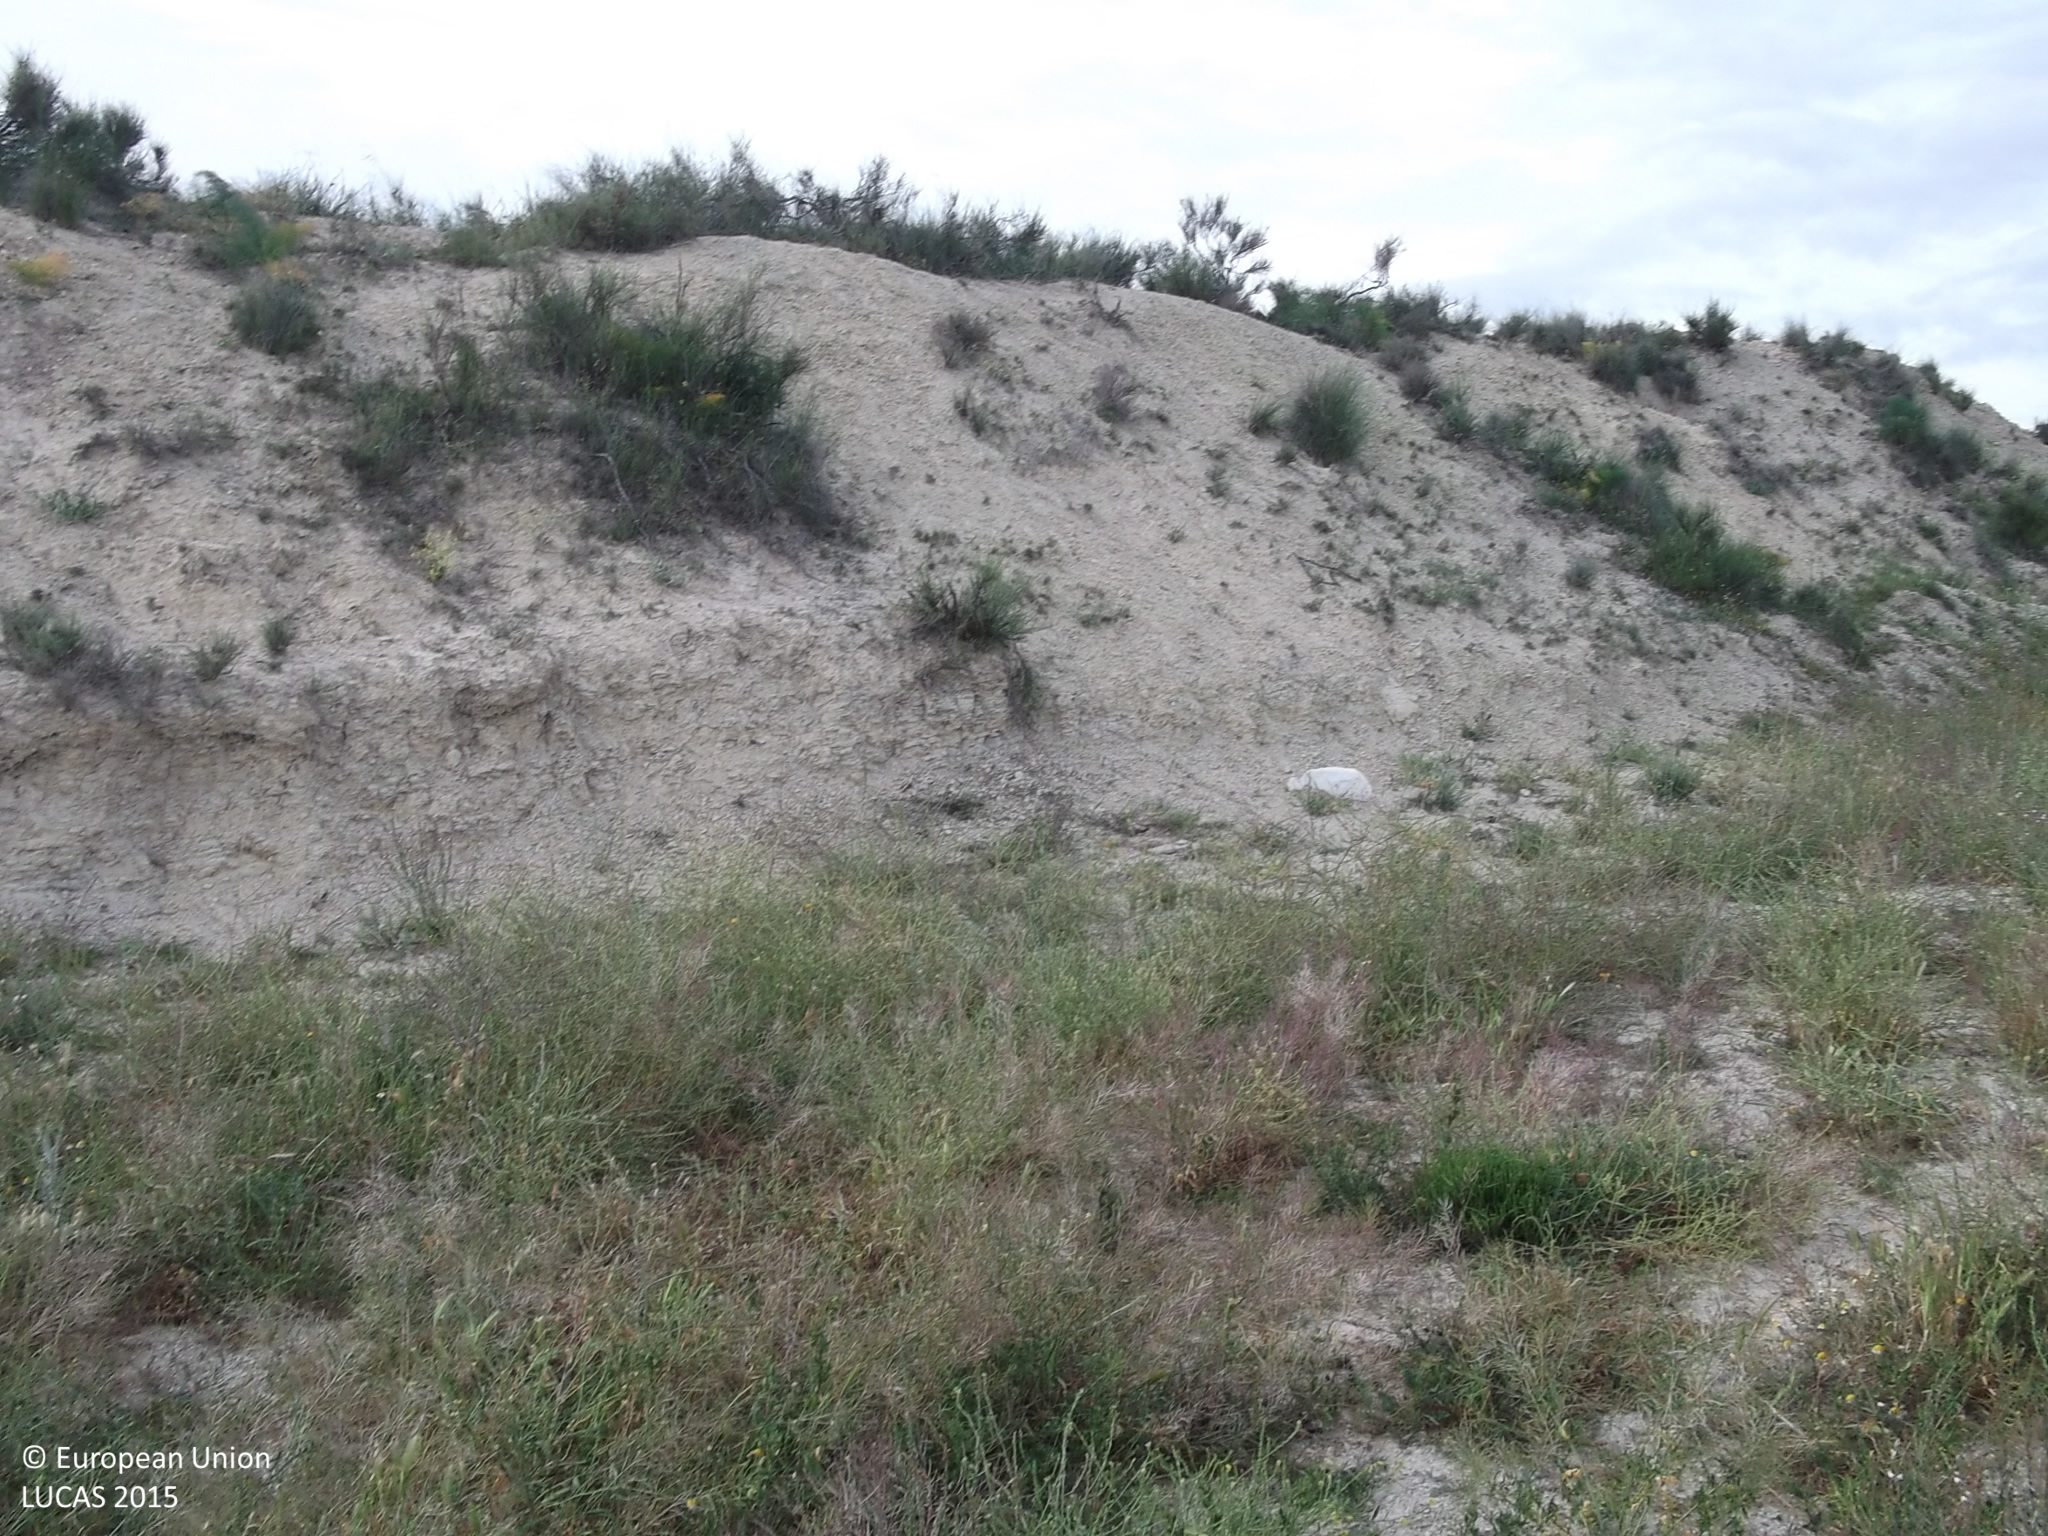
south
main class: Grassland
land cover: Spontaneously vegetated surfaces
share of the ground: 50 - 75 %
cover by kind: herbaceous plants 70 %, consolidated bare surface 30 %
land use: Fallow land
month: April
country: ES
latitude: 38.0250
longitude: -1.4346
